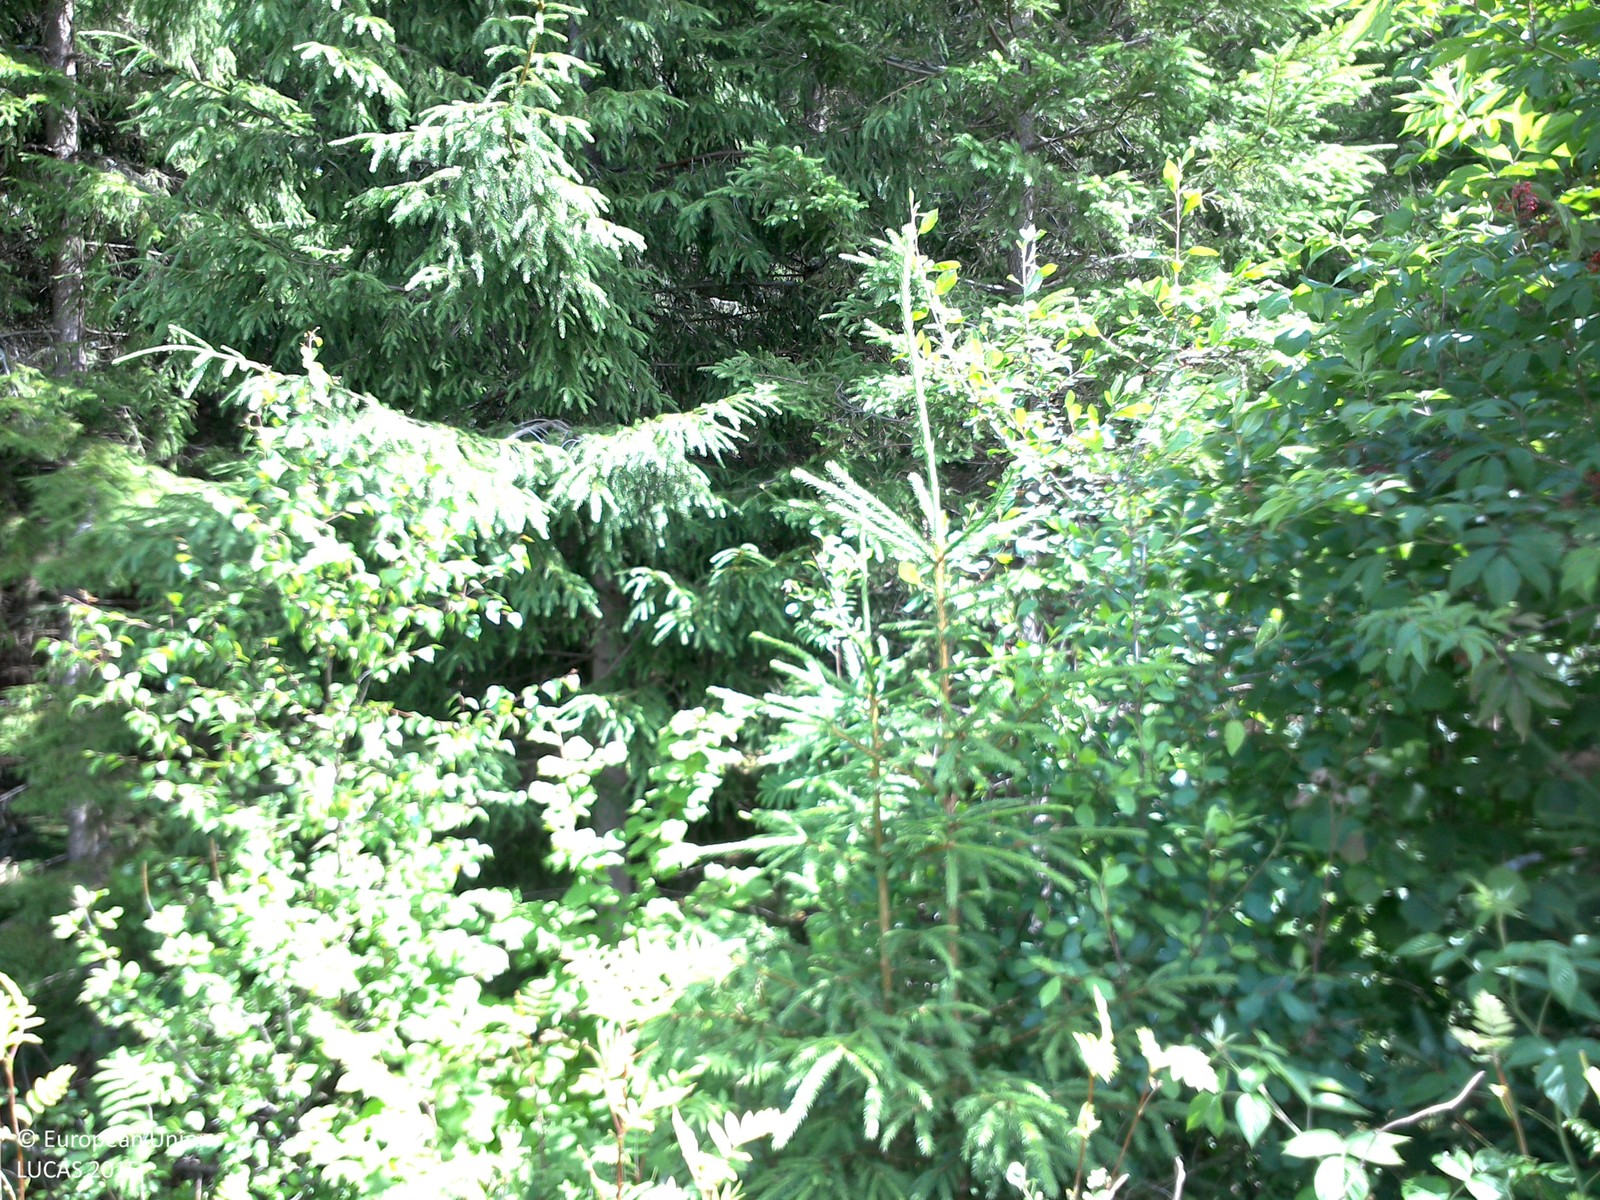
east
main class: Shrubland
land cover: Shrubland with sparse tree cover
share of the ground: > 75 %
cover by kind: shrubs 70 %, herbaceous plants 25 %, broadleaved forest trees 5 %
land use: Forestry
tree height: < 5 m
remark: Clear cut
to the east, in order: Shrubland with sparse tree cover; Spruce dominated coniferous woodland; Spruce dominated mixed woodland; Ditches and canals; Abandoned hedges; Other leguminous and mixtures for fodder; Grass margins; Ditches and canals; Grass margins; Common wheat
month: July
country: SE
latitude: 57.7937
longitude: 16.0701
